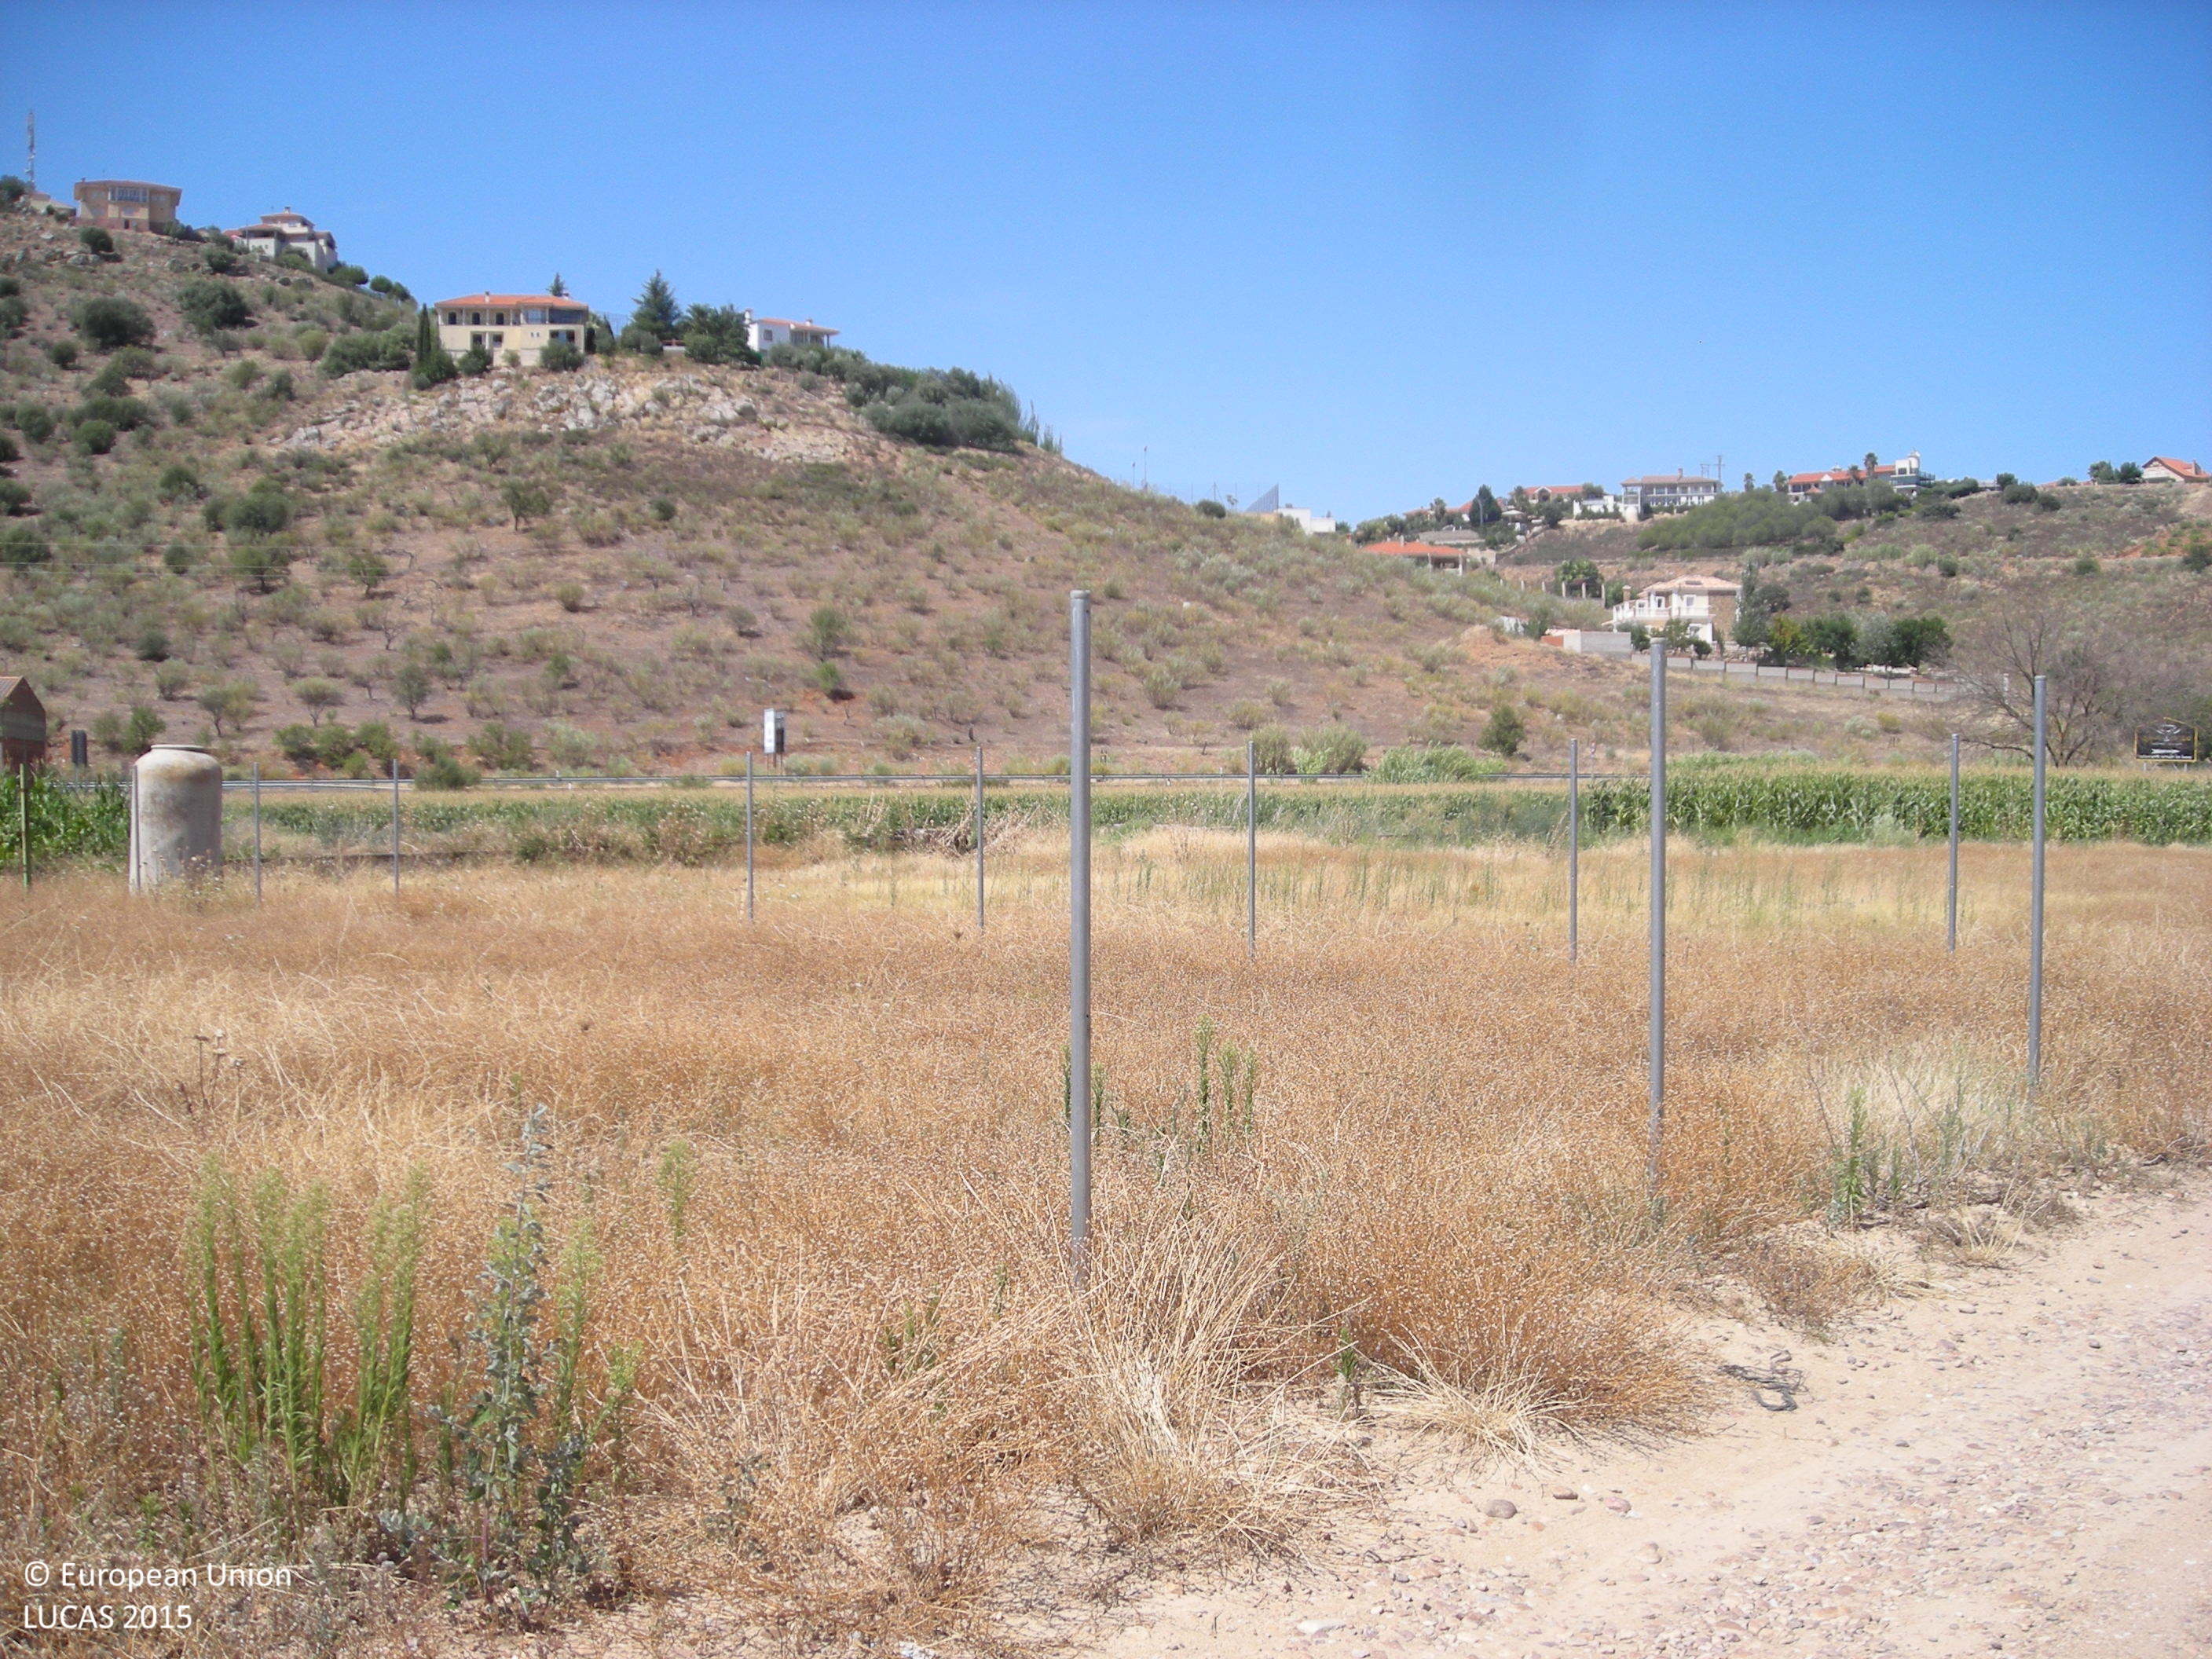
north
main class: Cropland
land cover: Olive groves
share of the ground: 25 - 50 %
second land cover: Other bare soil
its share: > 75 %
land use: Agriculture (excluding fallow land and kitchen gardens)
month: July
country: ES
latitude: 38.9685
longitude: -5.9673
